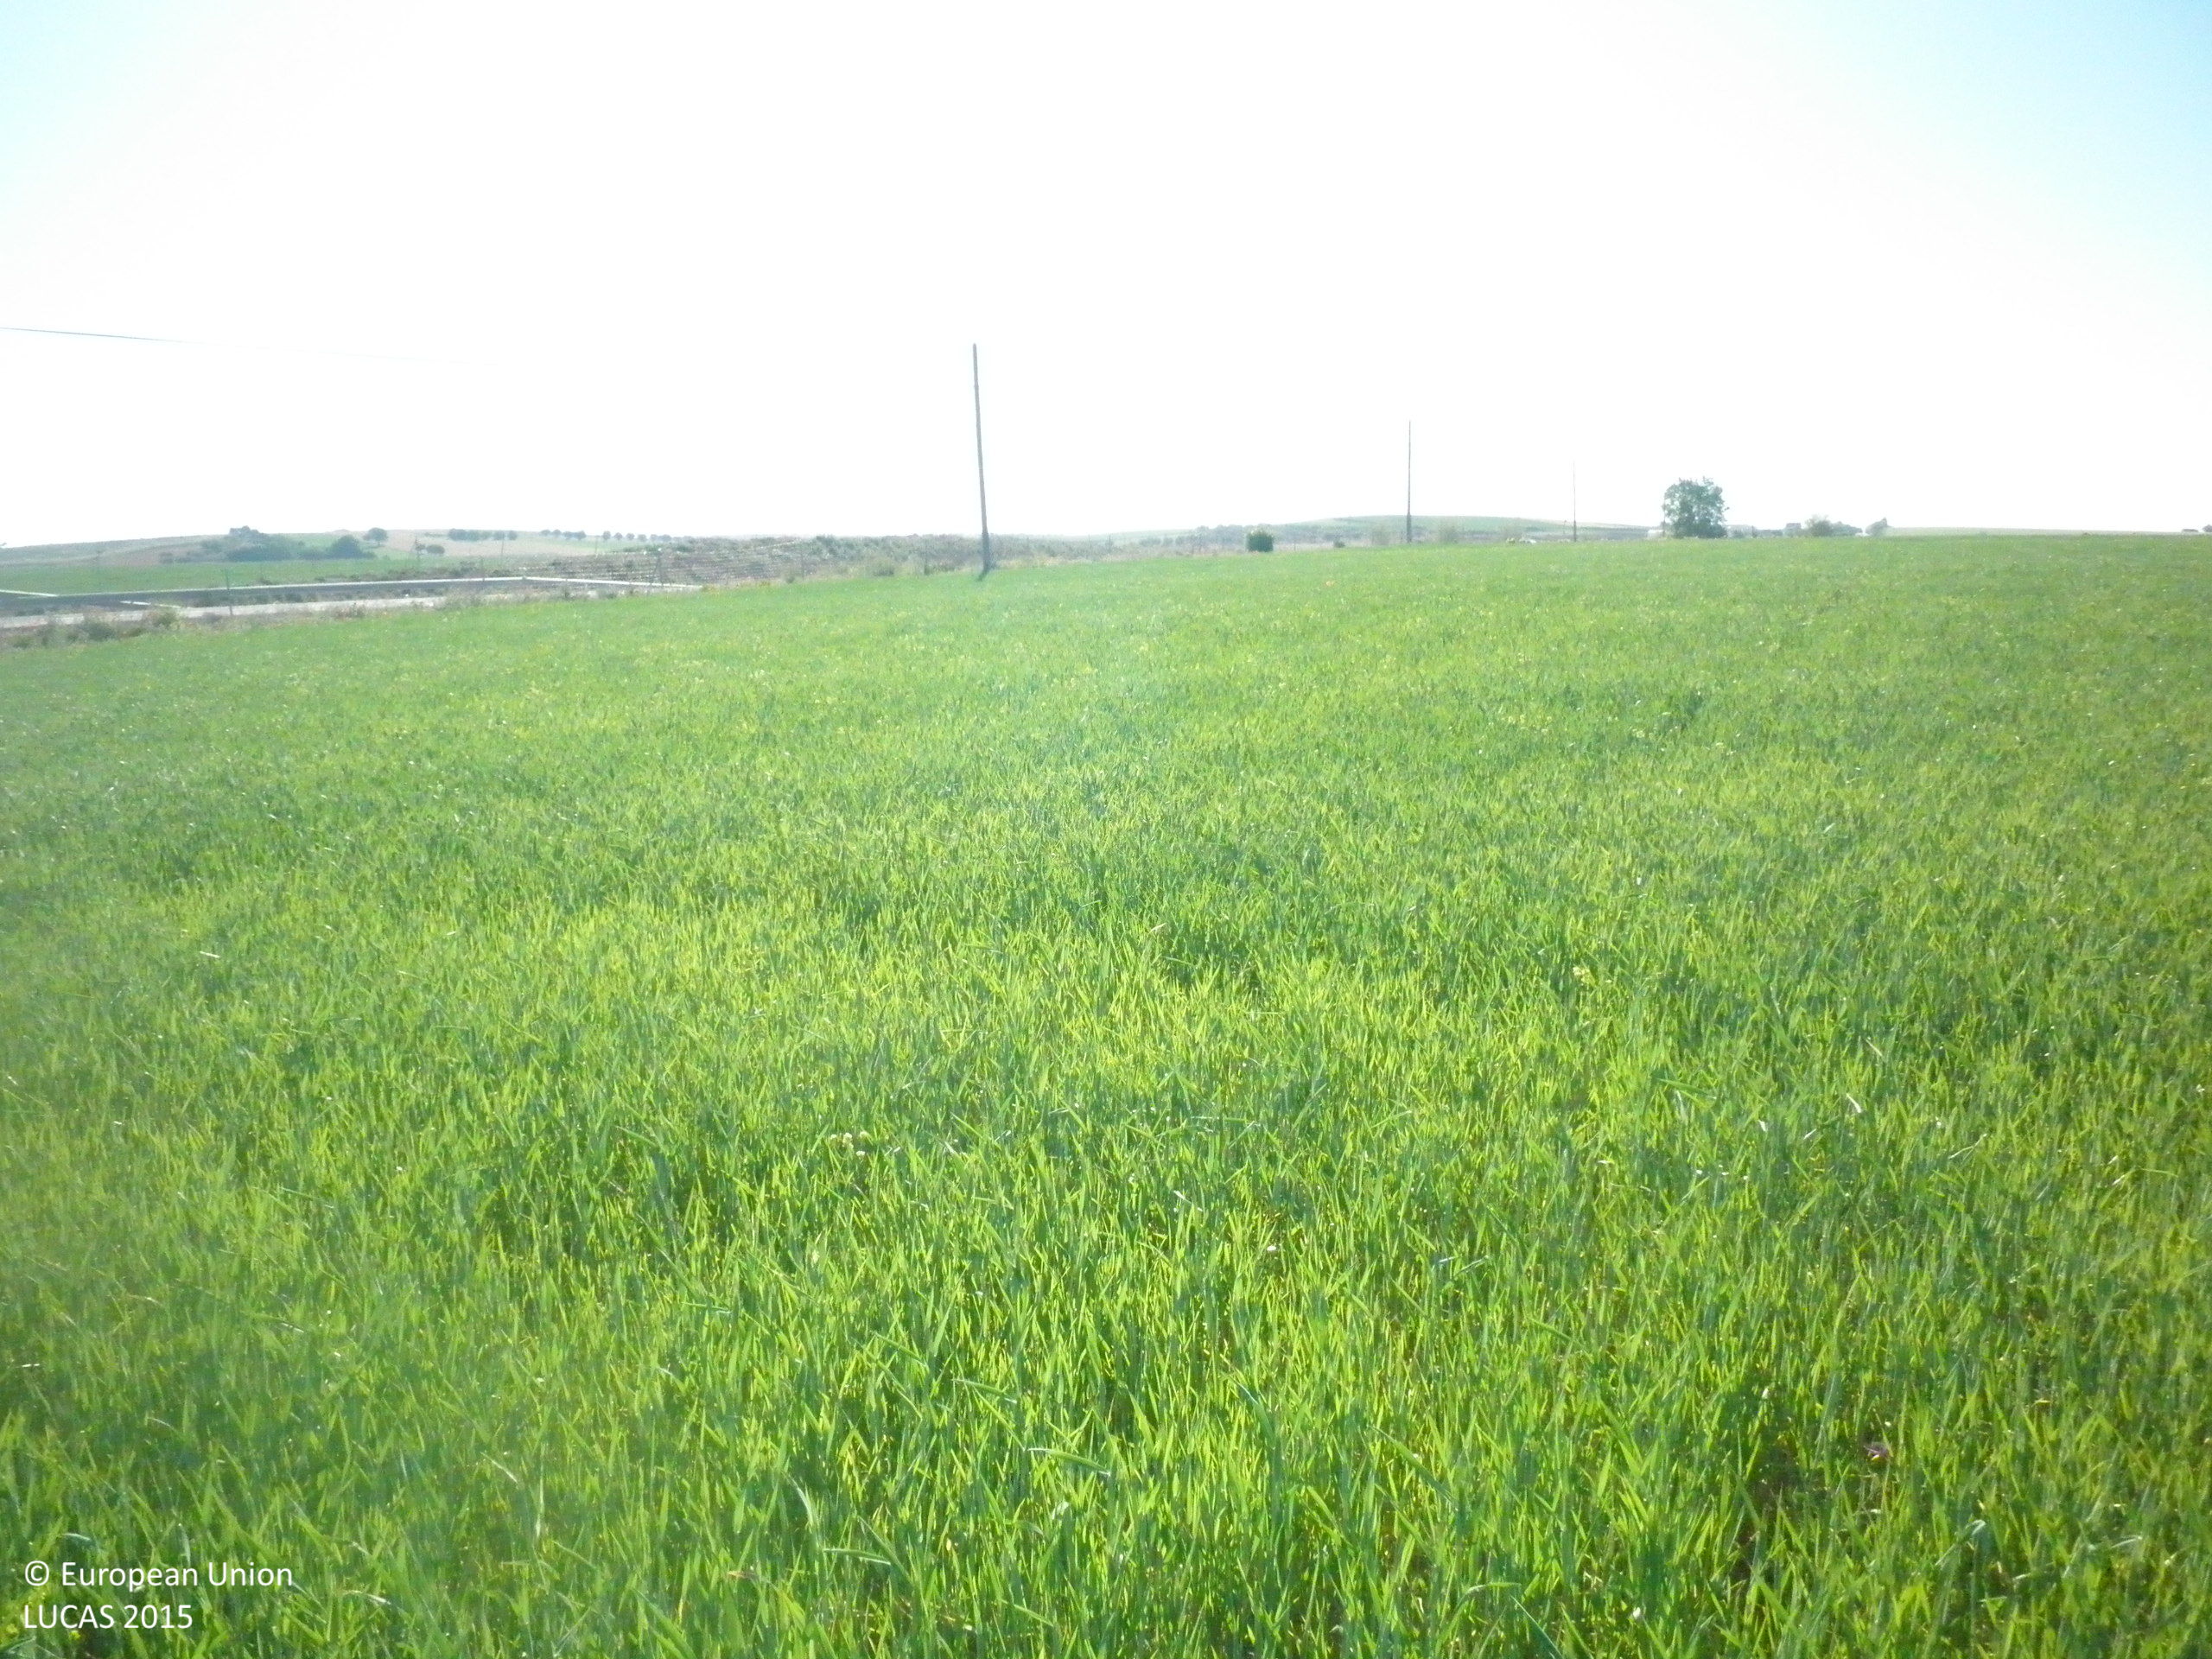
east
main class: Cropland
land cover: Durum wheat
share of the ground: > 75 %
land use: Agriculture (excluding fallow land and kitchen gardens)
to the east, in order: Durum wheat; Electric lines; Grass margins; Tracks; Grass margins; Fences; Grassland without tree/shrub cover; Paved roads, cycling and walking lanes; Grassland without tree/shrub cover; Fences; Barley; Electric lines; Barley
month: May
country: ES
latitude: 39.4724
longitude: -2.7193
